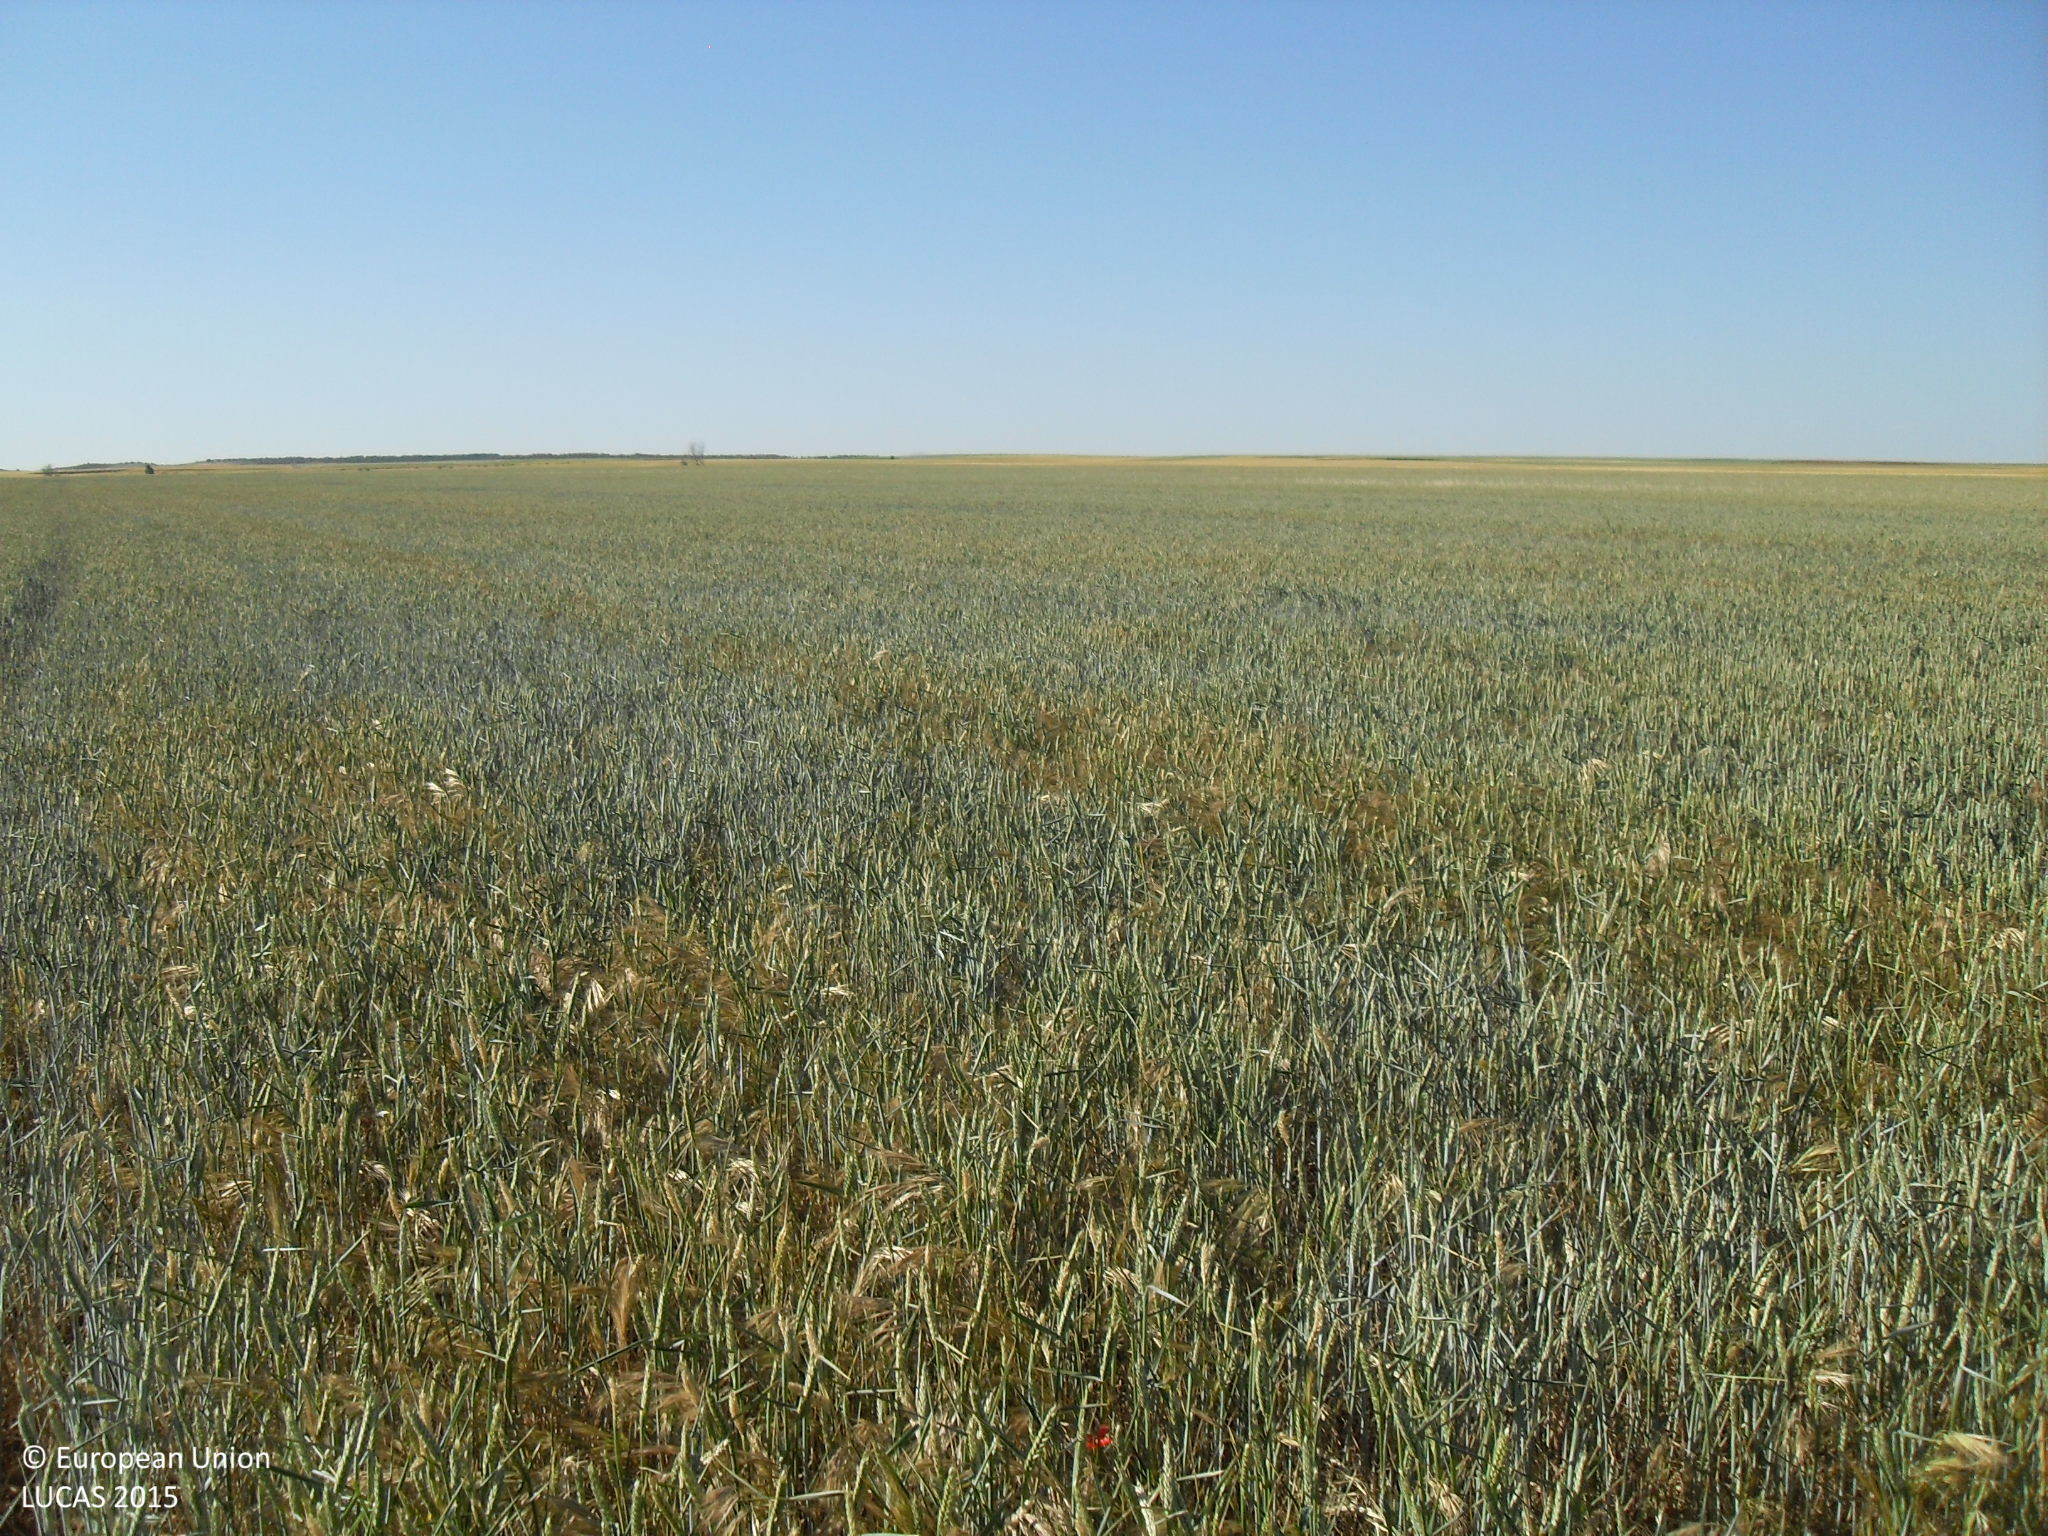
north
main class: Cropland
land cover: Common wheat
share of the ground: > 75 %
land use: Agriculture (excluding fallow land and kitchen gardens)
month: May
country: ES
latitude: 41.1189
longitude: -5.4024
